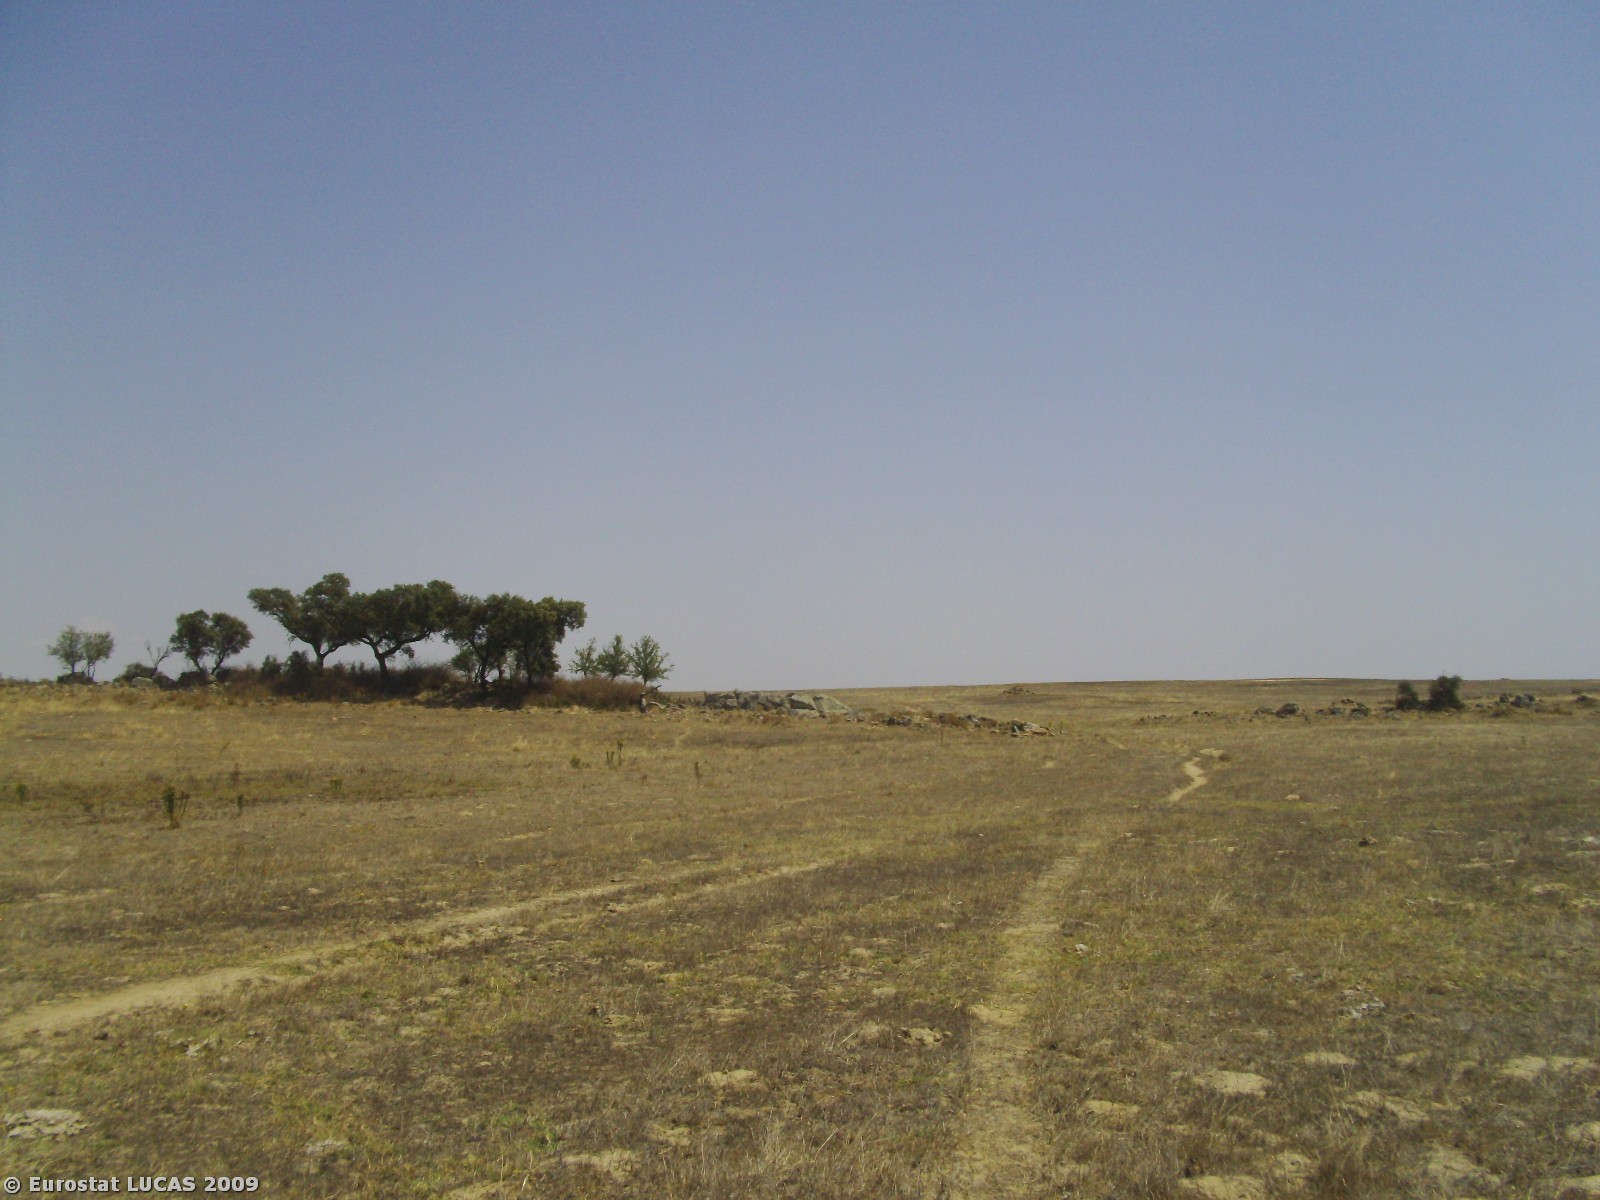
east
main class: Grassland
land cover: Grassland without tree/shrub cover
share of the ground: 25 - 50 %
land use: Agriculture (excluding fallow land and kitchen gardens)
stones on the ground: < 10 %
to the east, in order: Grassland without tree/shrub cover; Bare land; Grassland without tree/shrub cover
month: August
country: PT
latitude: 38.4278
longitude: -8.0590
